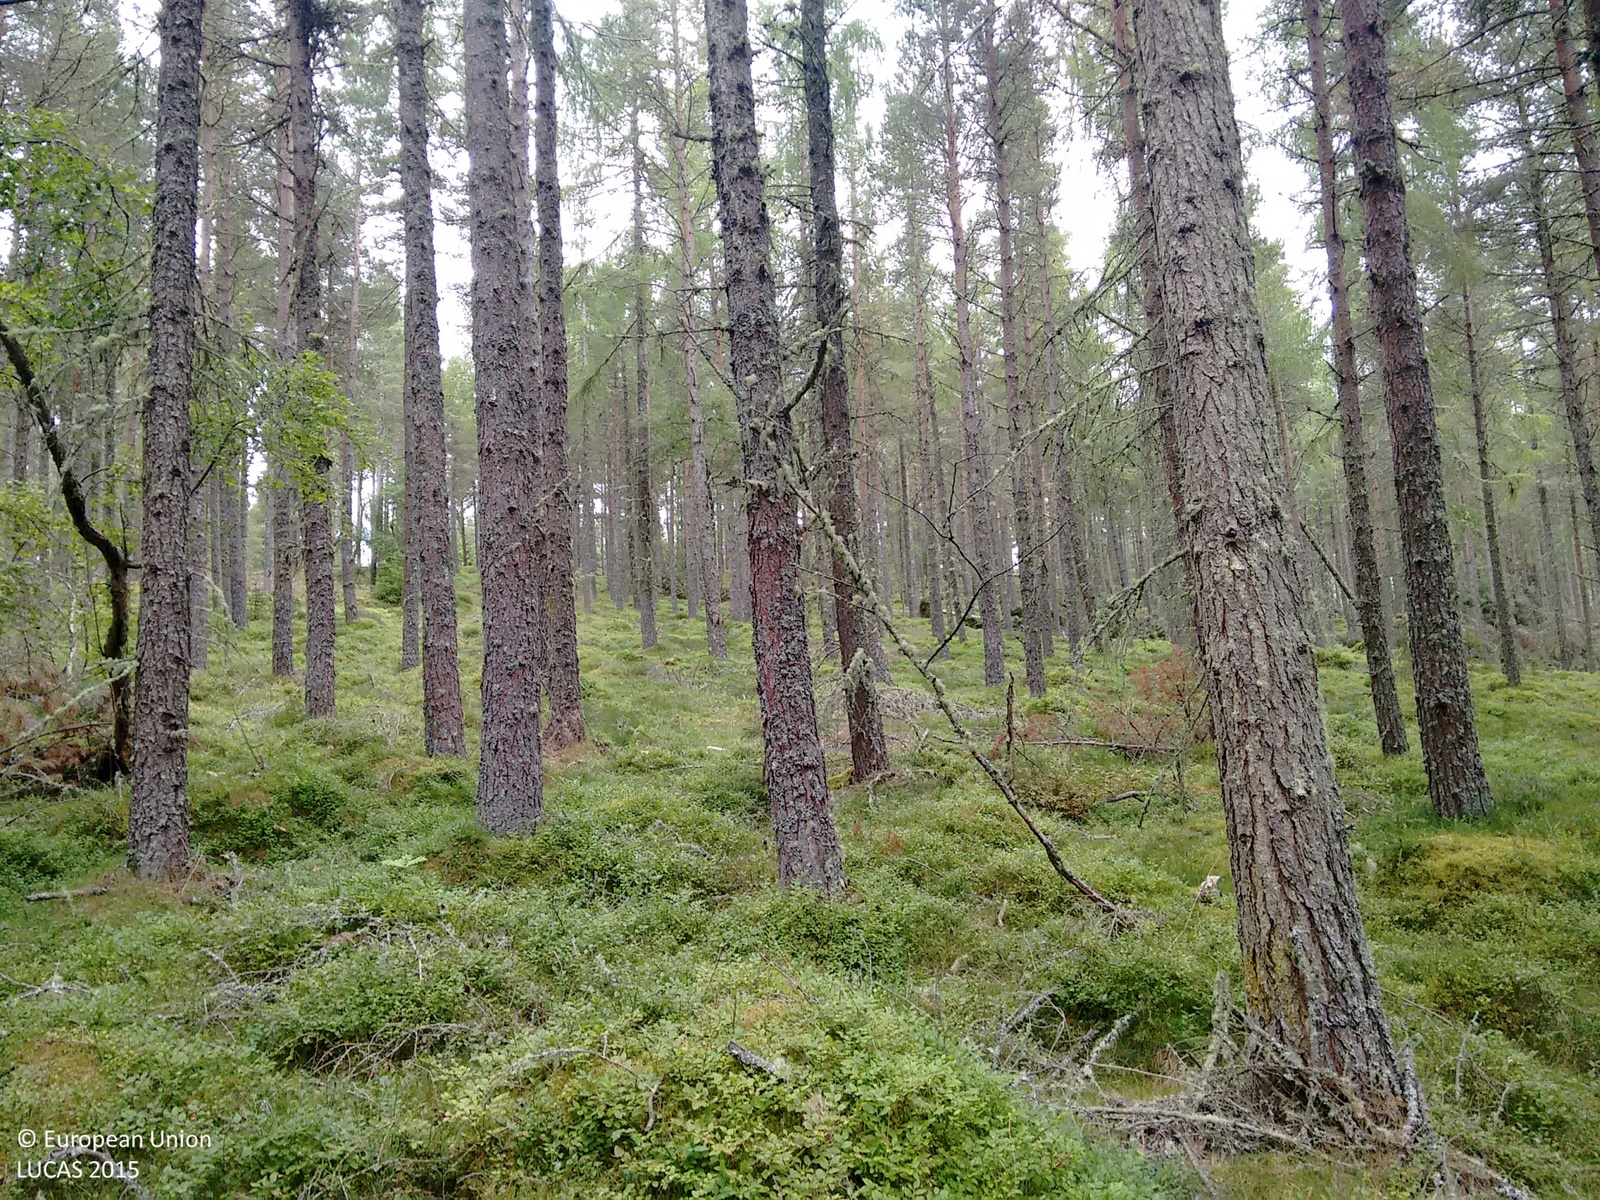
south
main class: Woodland
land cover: Pine dominated coniferous woodland
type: hemiboreal forest and nemoral coniferous forest and mixed broadleaved-coniferous forest
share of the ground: > 75 %
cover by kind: coniferous forest trees 80 %, shrubs 15 %, herbaceous plants 5 %
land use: Forestry
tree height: > 5 m
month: September
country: GB
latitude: 57.7407
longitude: -4.3135
